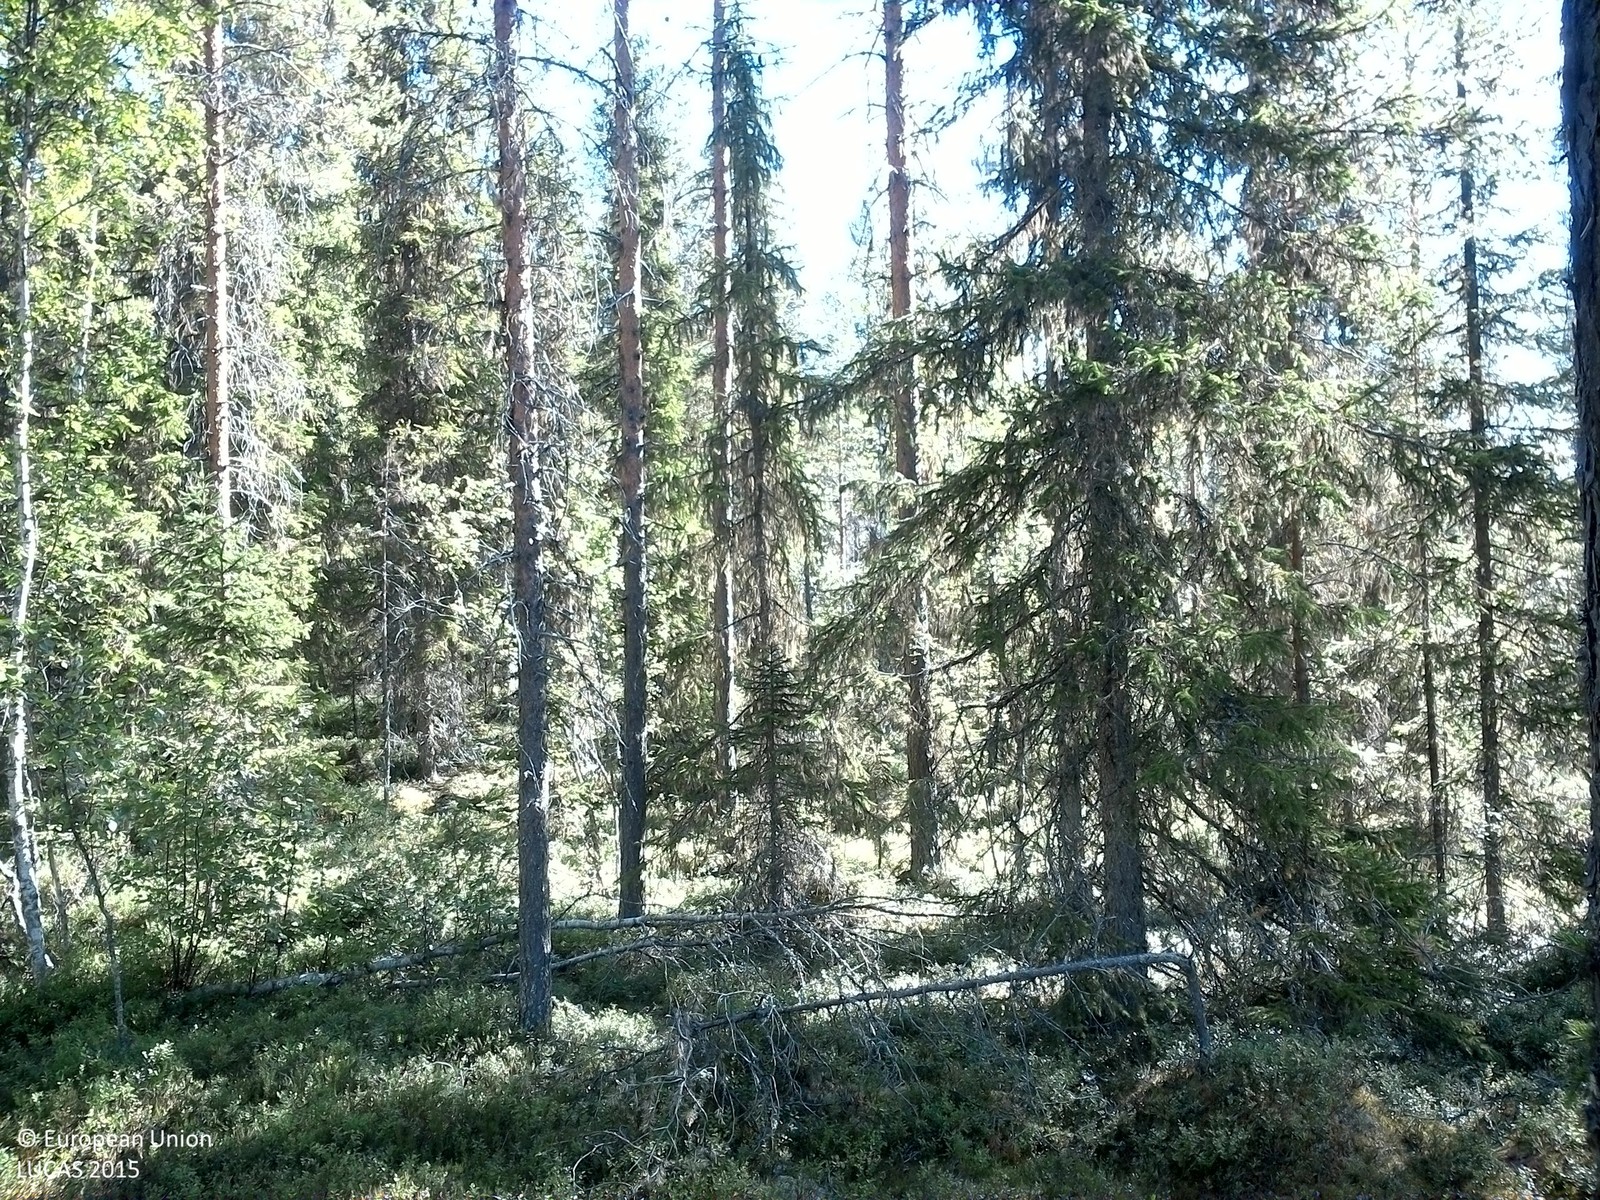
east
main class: Woodland
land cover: Pine dominated coniferous woodland
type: boreal forest
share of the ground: 50 - 75 %
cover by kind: coniferous forest trees 60 %, shrubs 30 %, lichens and mosses 10 %
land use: Forestry
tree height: > 5 m
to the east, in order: Pine dominated coniferous woodland; Spruce dominated mixed woodland; Pine dominated coniferous woodland; Spruce dominated coniferous woodland; Spruce dominated mixed woodland; Pine dominated coniferous woodland
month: August
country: SE
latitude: 63.6840
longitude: 17.7165
